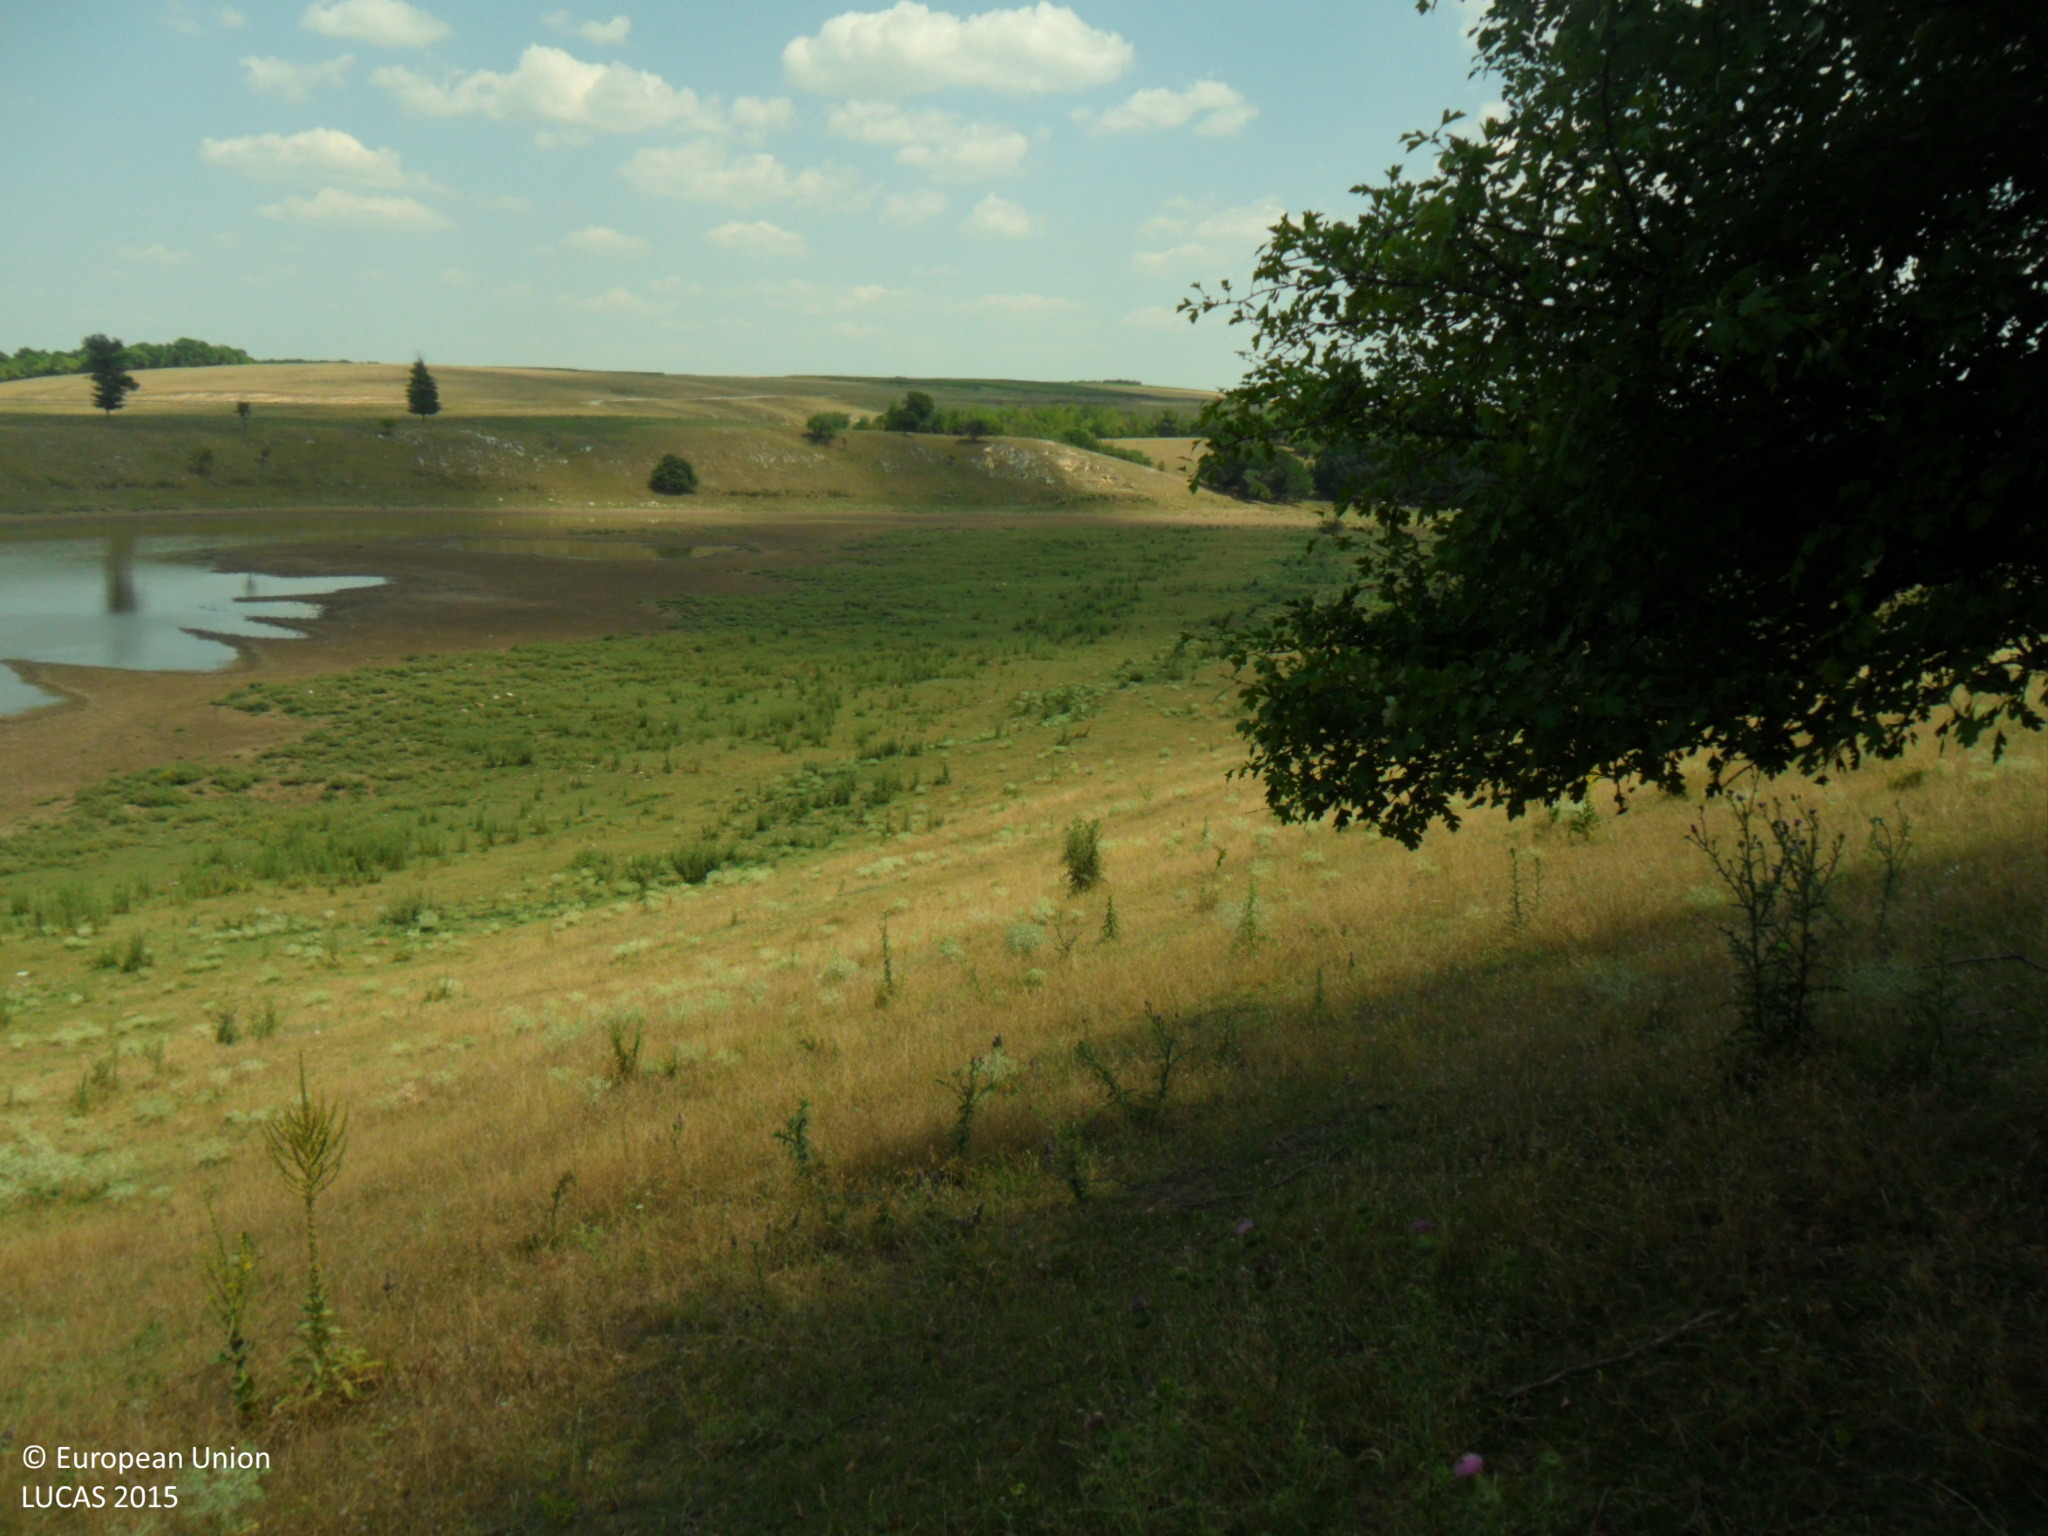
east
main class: Grassland
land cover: Grassland with sparse tree/shrub cover
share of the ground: > 75 %
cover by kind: herbaceous plants 90 %, broadleaved forest trees 5 %, shrubs 5 %
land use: Forestry
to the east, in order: Grassland with sparse tree/shrub cover; Grassland without tree/shrub cover; Tracks; Grassland without tree/shrub cover; Tracks; Grassland without tree/shrub cover; Other bare soil
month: July
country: BG
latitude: 43.6438
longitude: 27.2714
